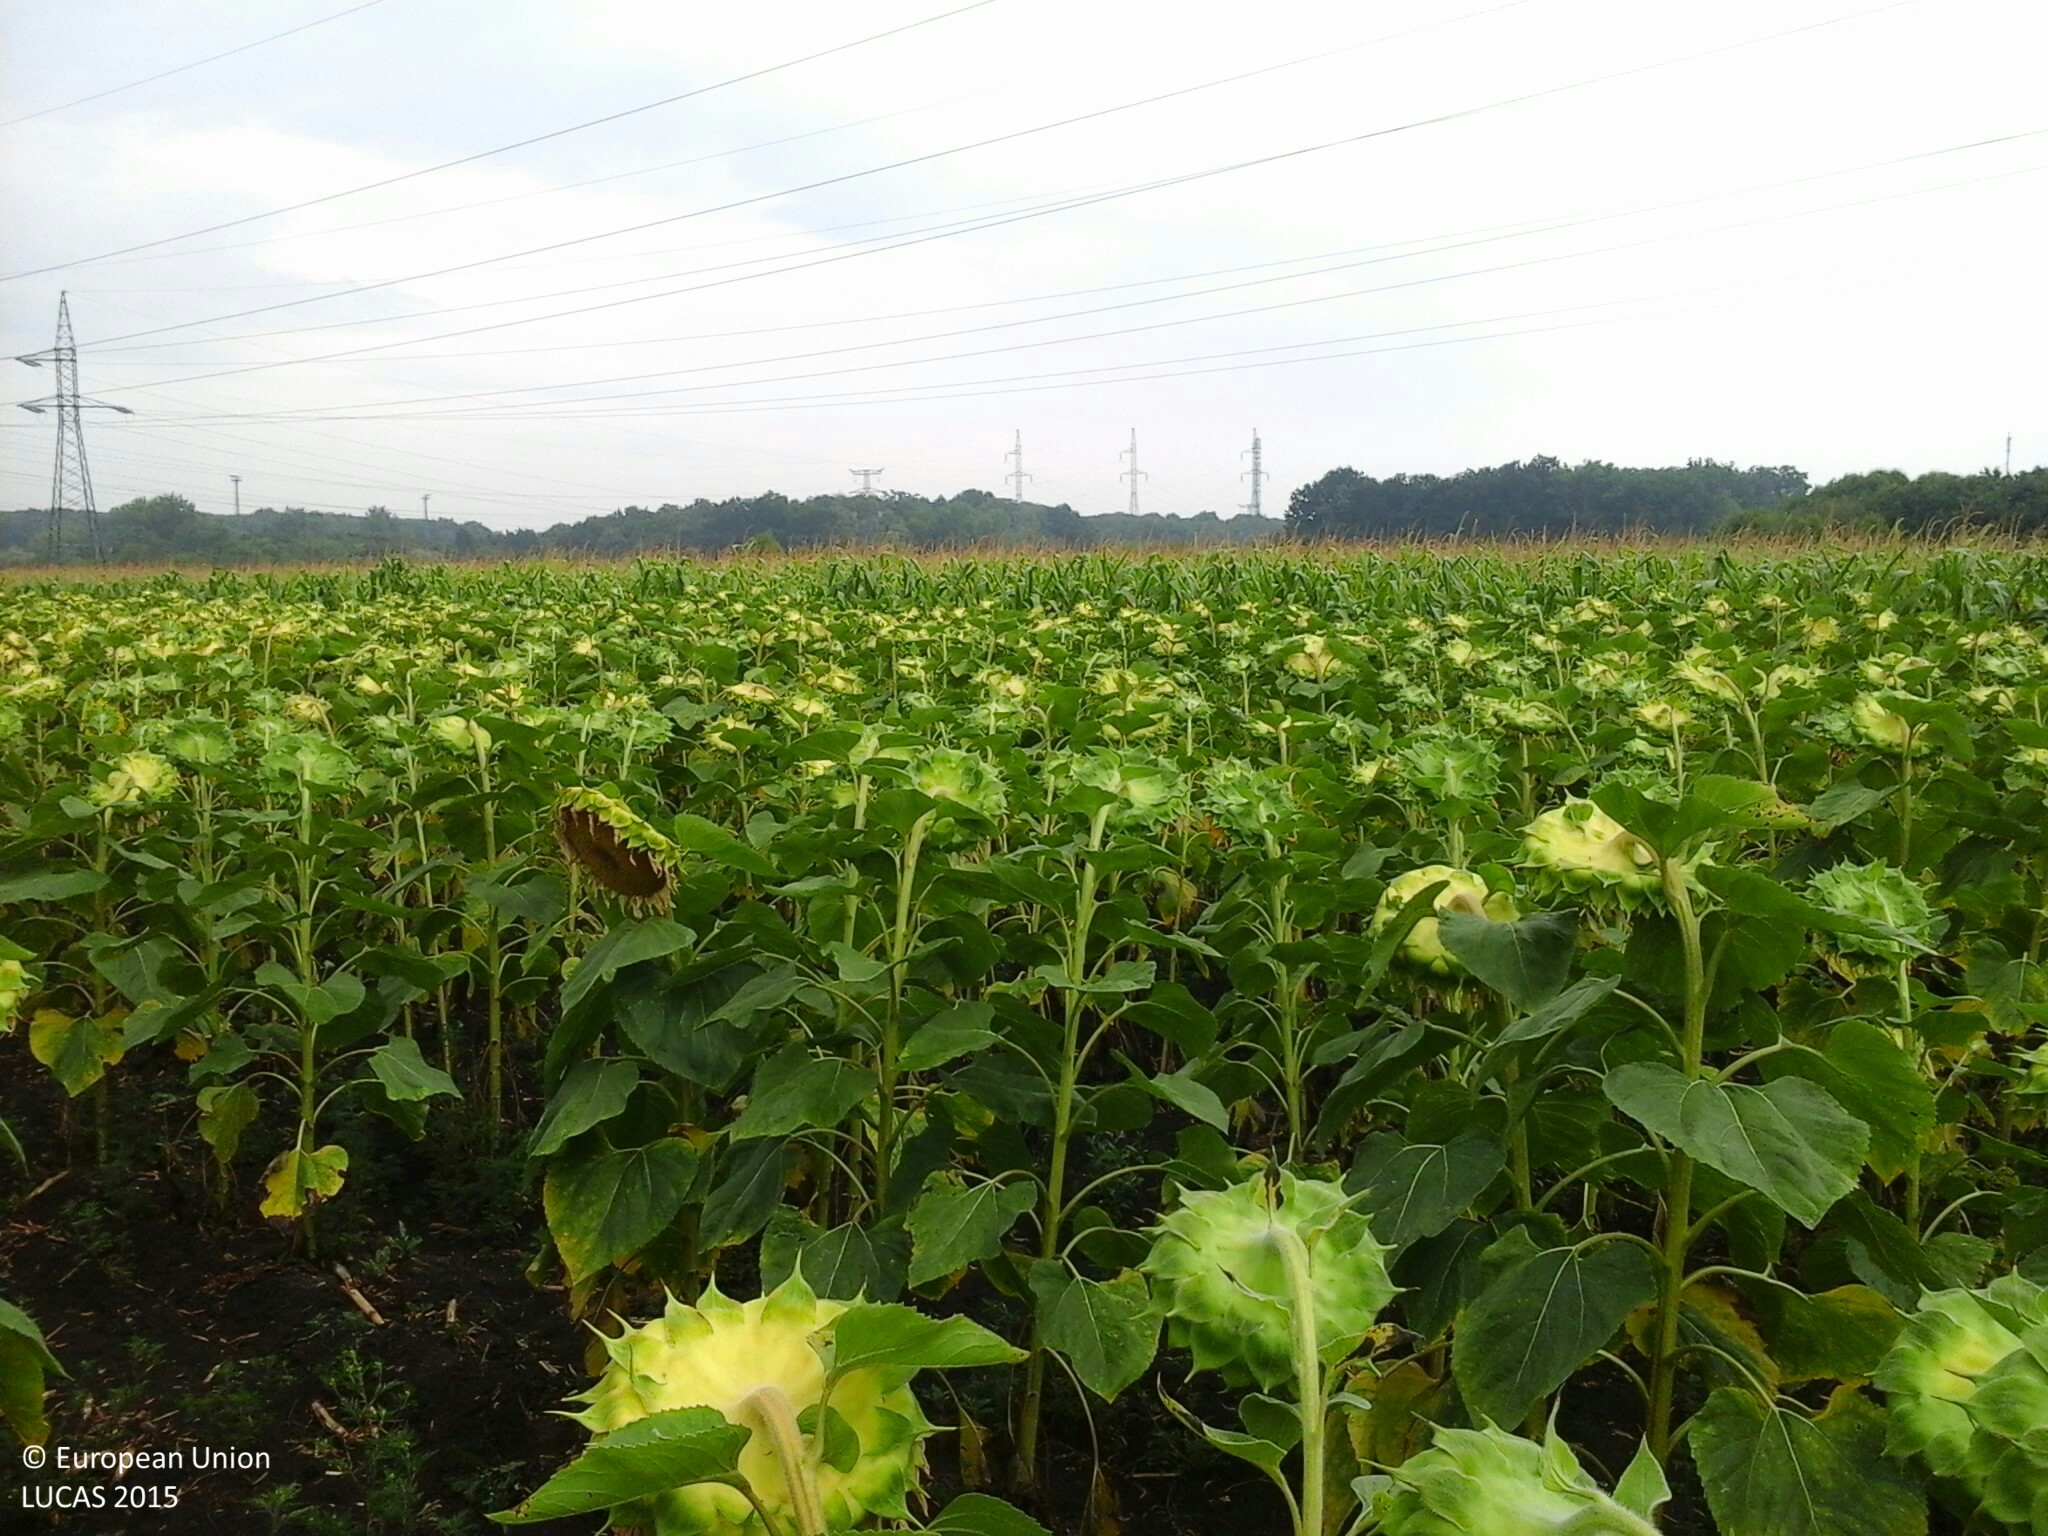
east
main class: Cropland
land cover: Sunflower
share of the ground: > 75 %
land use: Agriculture (excluding fallow land and kitchen gardens)
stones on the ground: < 10 %
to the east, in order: Sunflower; Maize; Electric lines; Sunflower; Tracks; Artificial constructions; Grassland with sparse tree/shrub cover
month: August
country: HU
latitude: 47.9229
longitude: 21.0260
